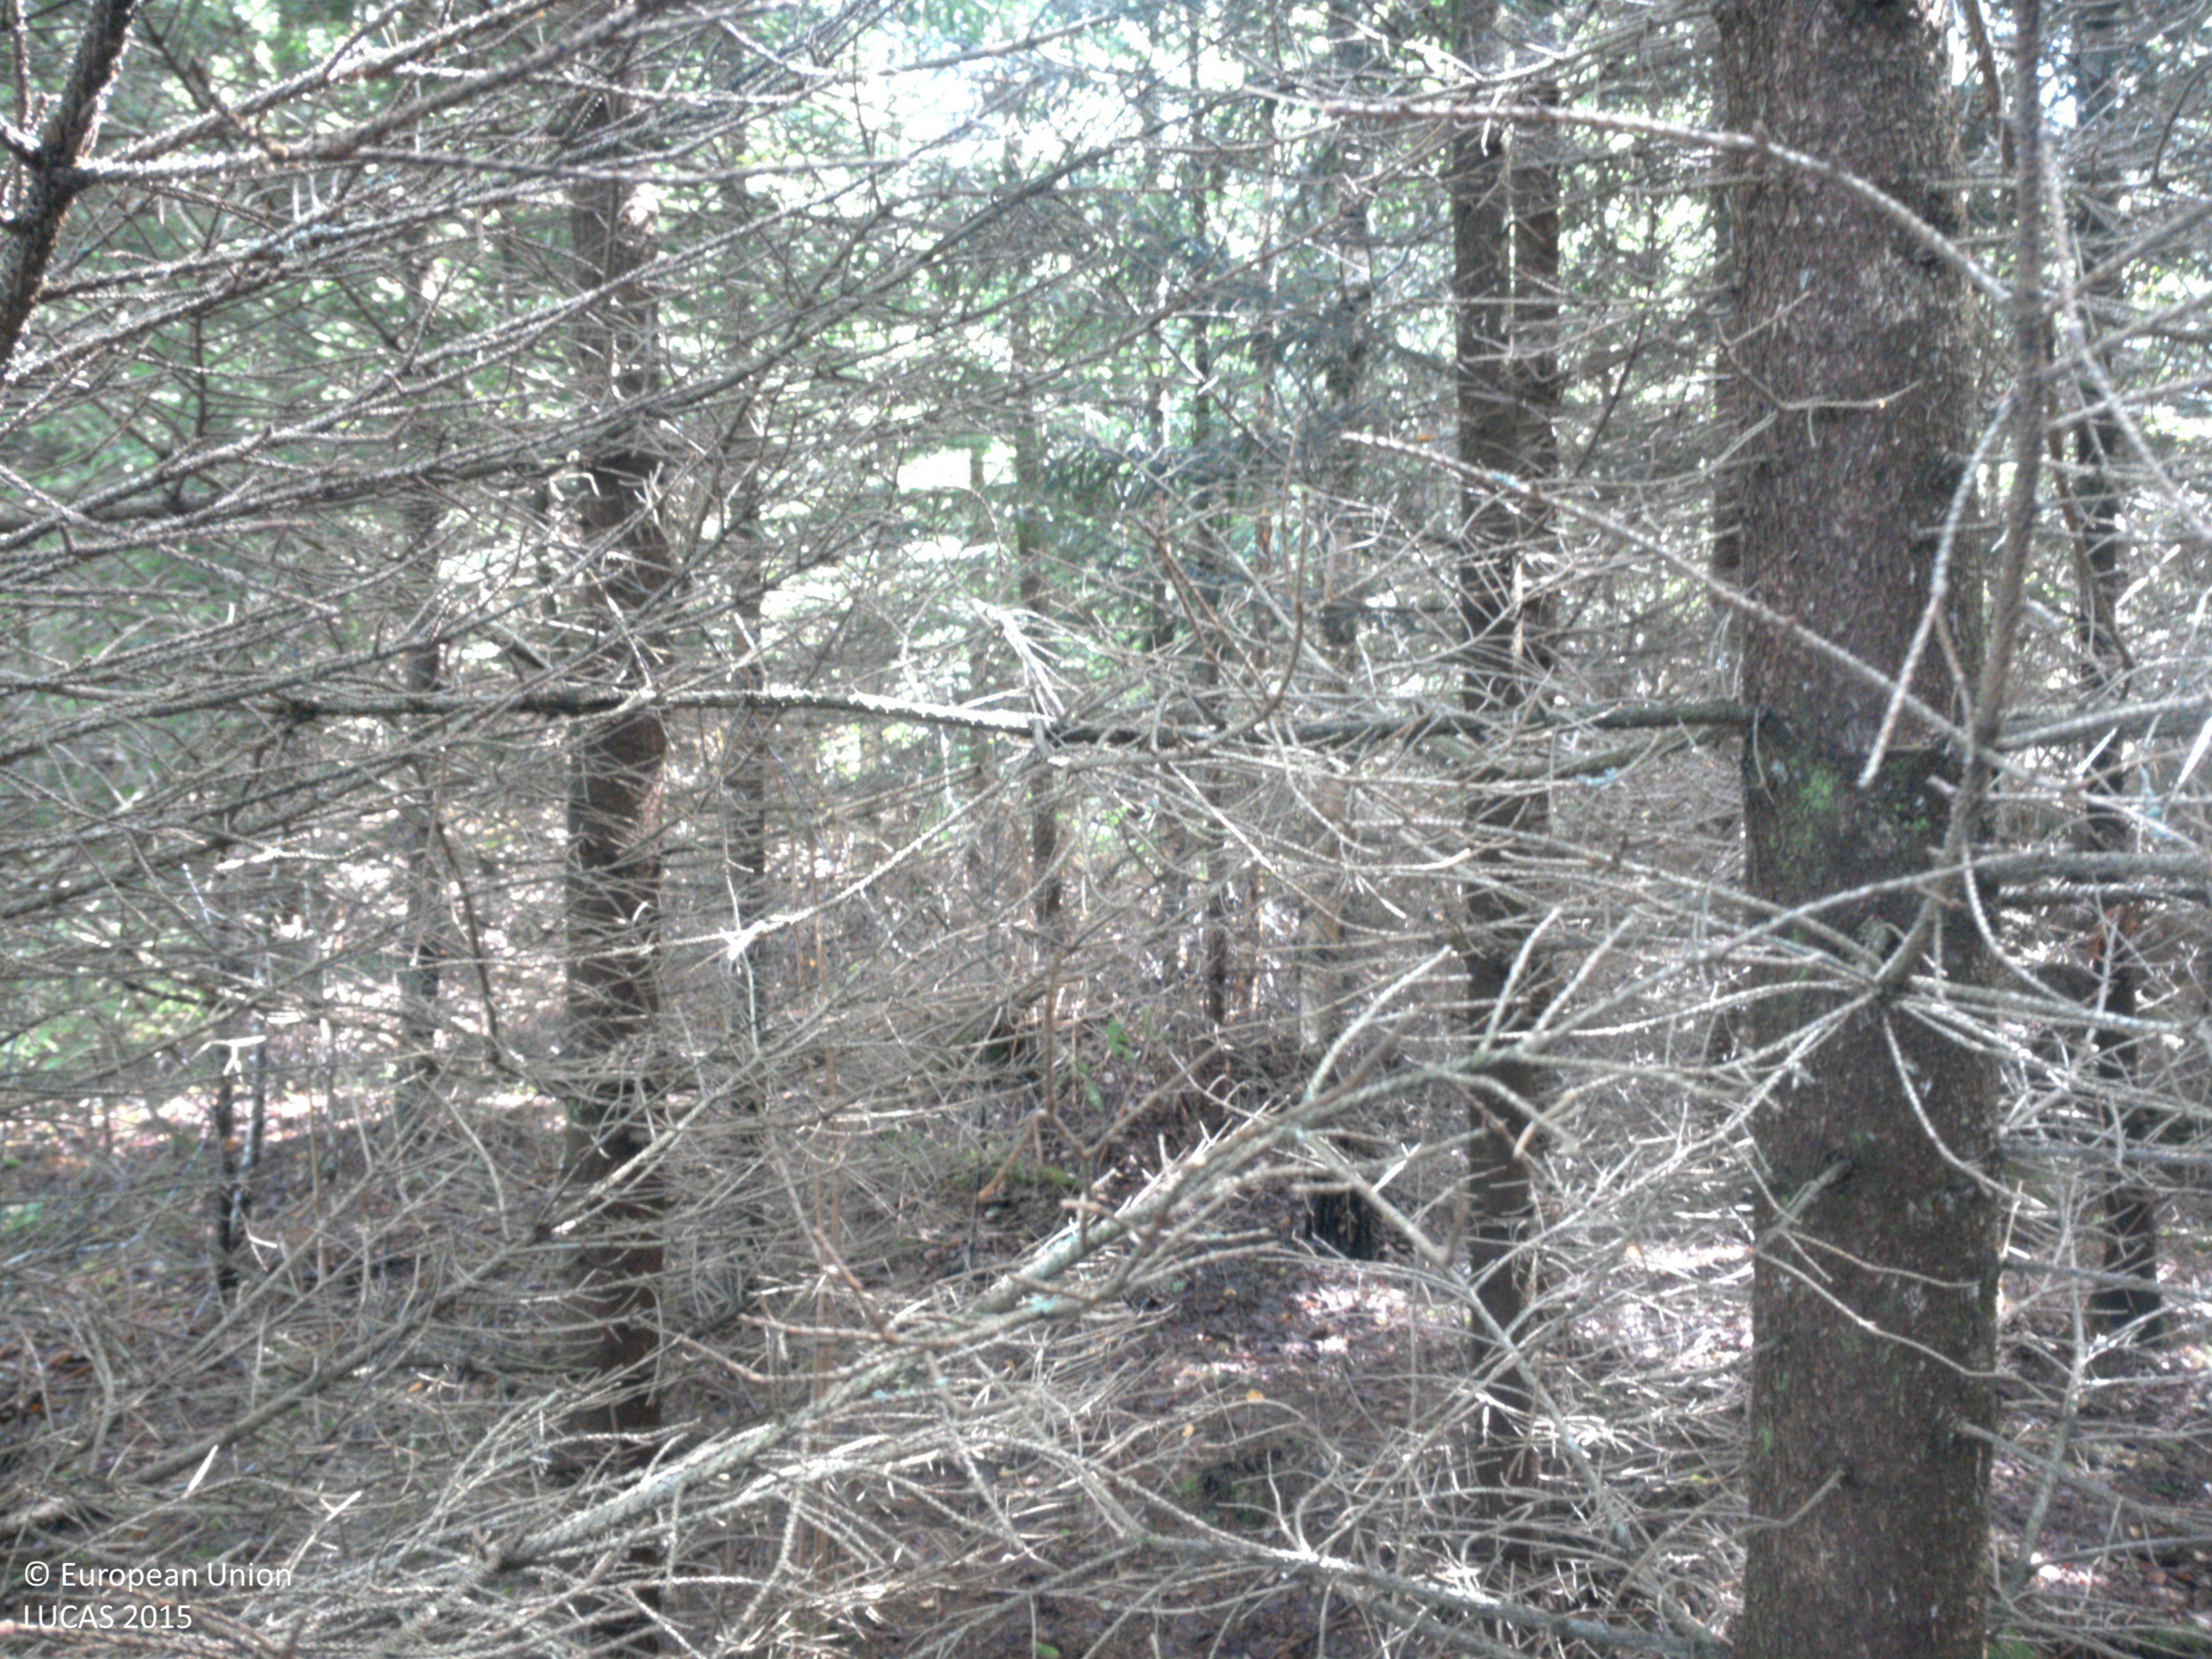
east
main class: Woodland
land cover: Spruce dominated coniferous woodland
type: boreal forest
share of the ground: > 75 %
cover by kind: coniferous forest trees 80 %, shrubs 20 %
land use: Forestry
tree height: > 5 m
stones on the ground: 10 - 25 %
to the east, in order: Spruce dominated coniferous woodland; Spruce dominated mixed woodland; Spruce dominated coniferous woodland; Spruce dominated mixed woodland; Spruce dominated coniferous woodland
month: July
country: SE
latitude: 58.1329
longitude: 11.9832
